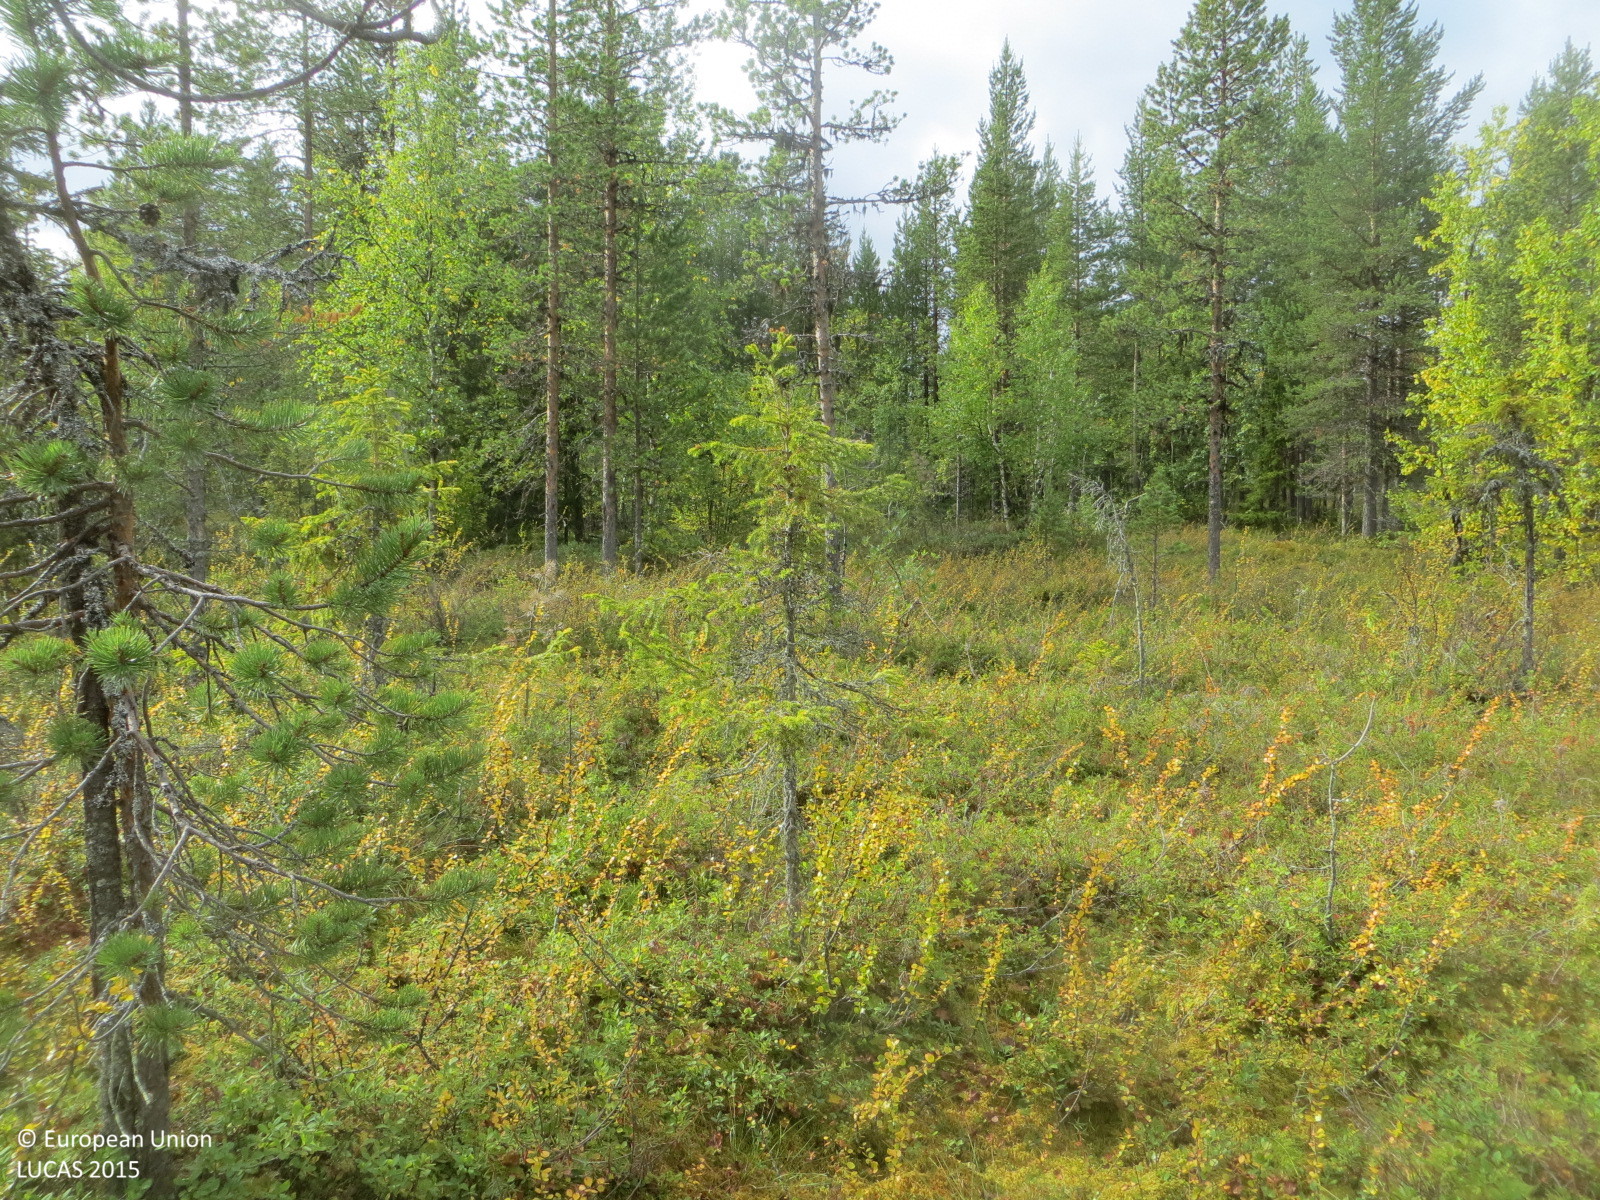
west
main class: Woodland
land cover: Pine dominated coniferous woodland
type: mire and swamp forests
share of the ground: 25 - 50 %
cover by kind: shrubs 60 %, coniferous forest trees 40 %
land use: Forestry
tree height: > 5 m
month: September
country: FI
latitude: 68.1276
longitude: 24.2328
